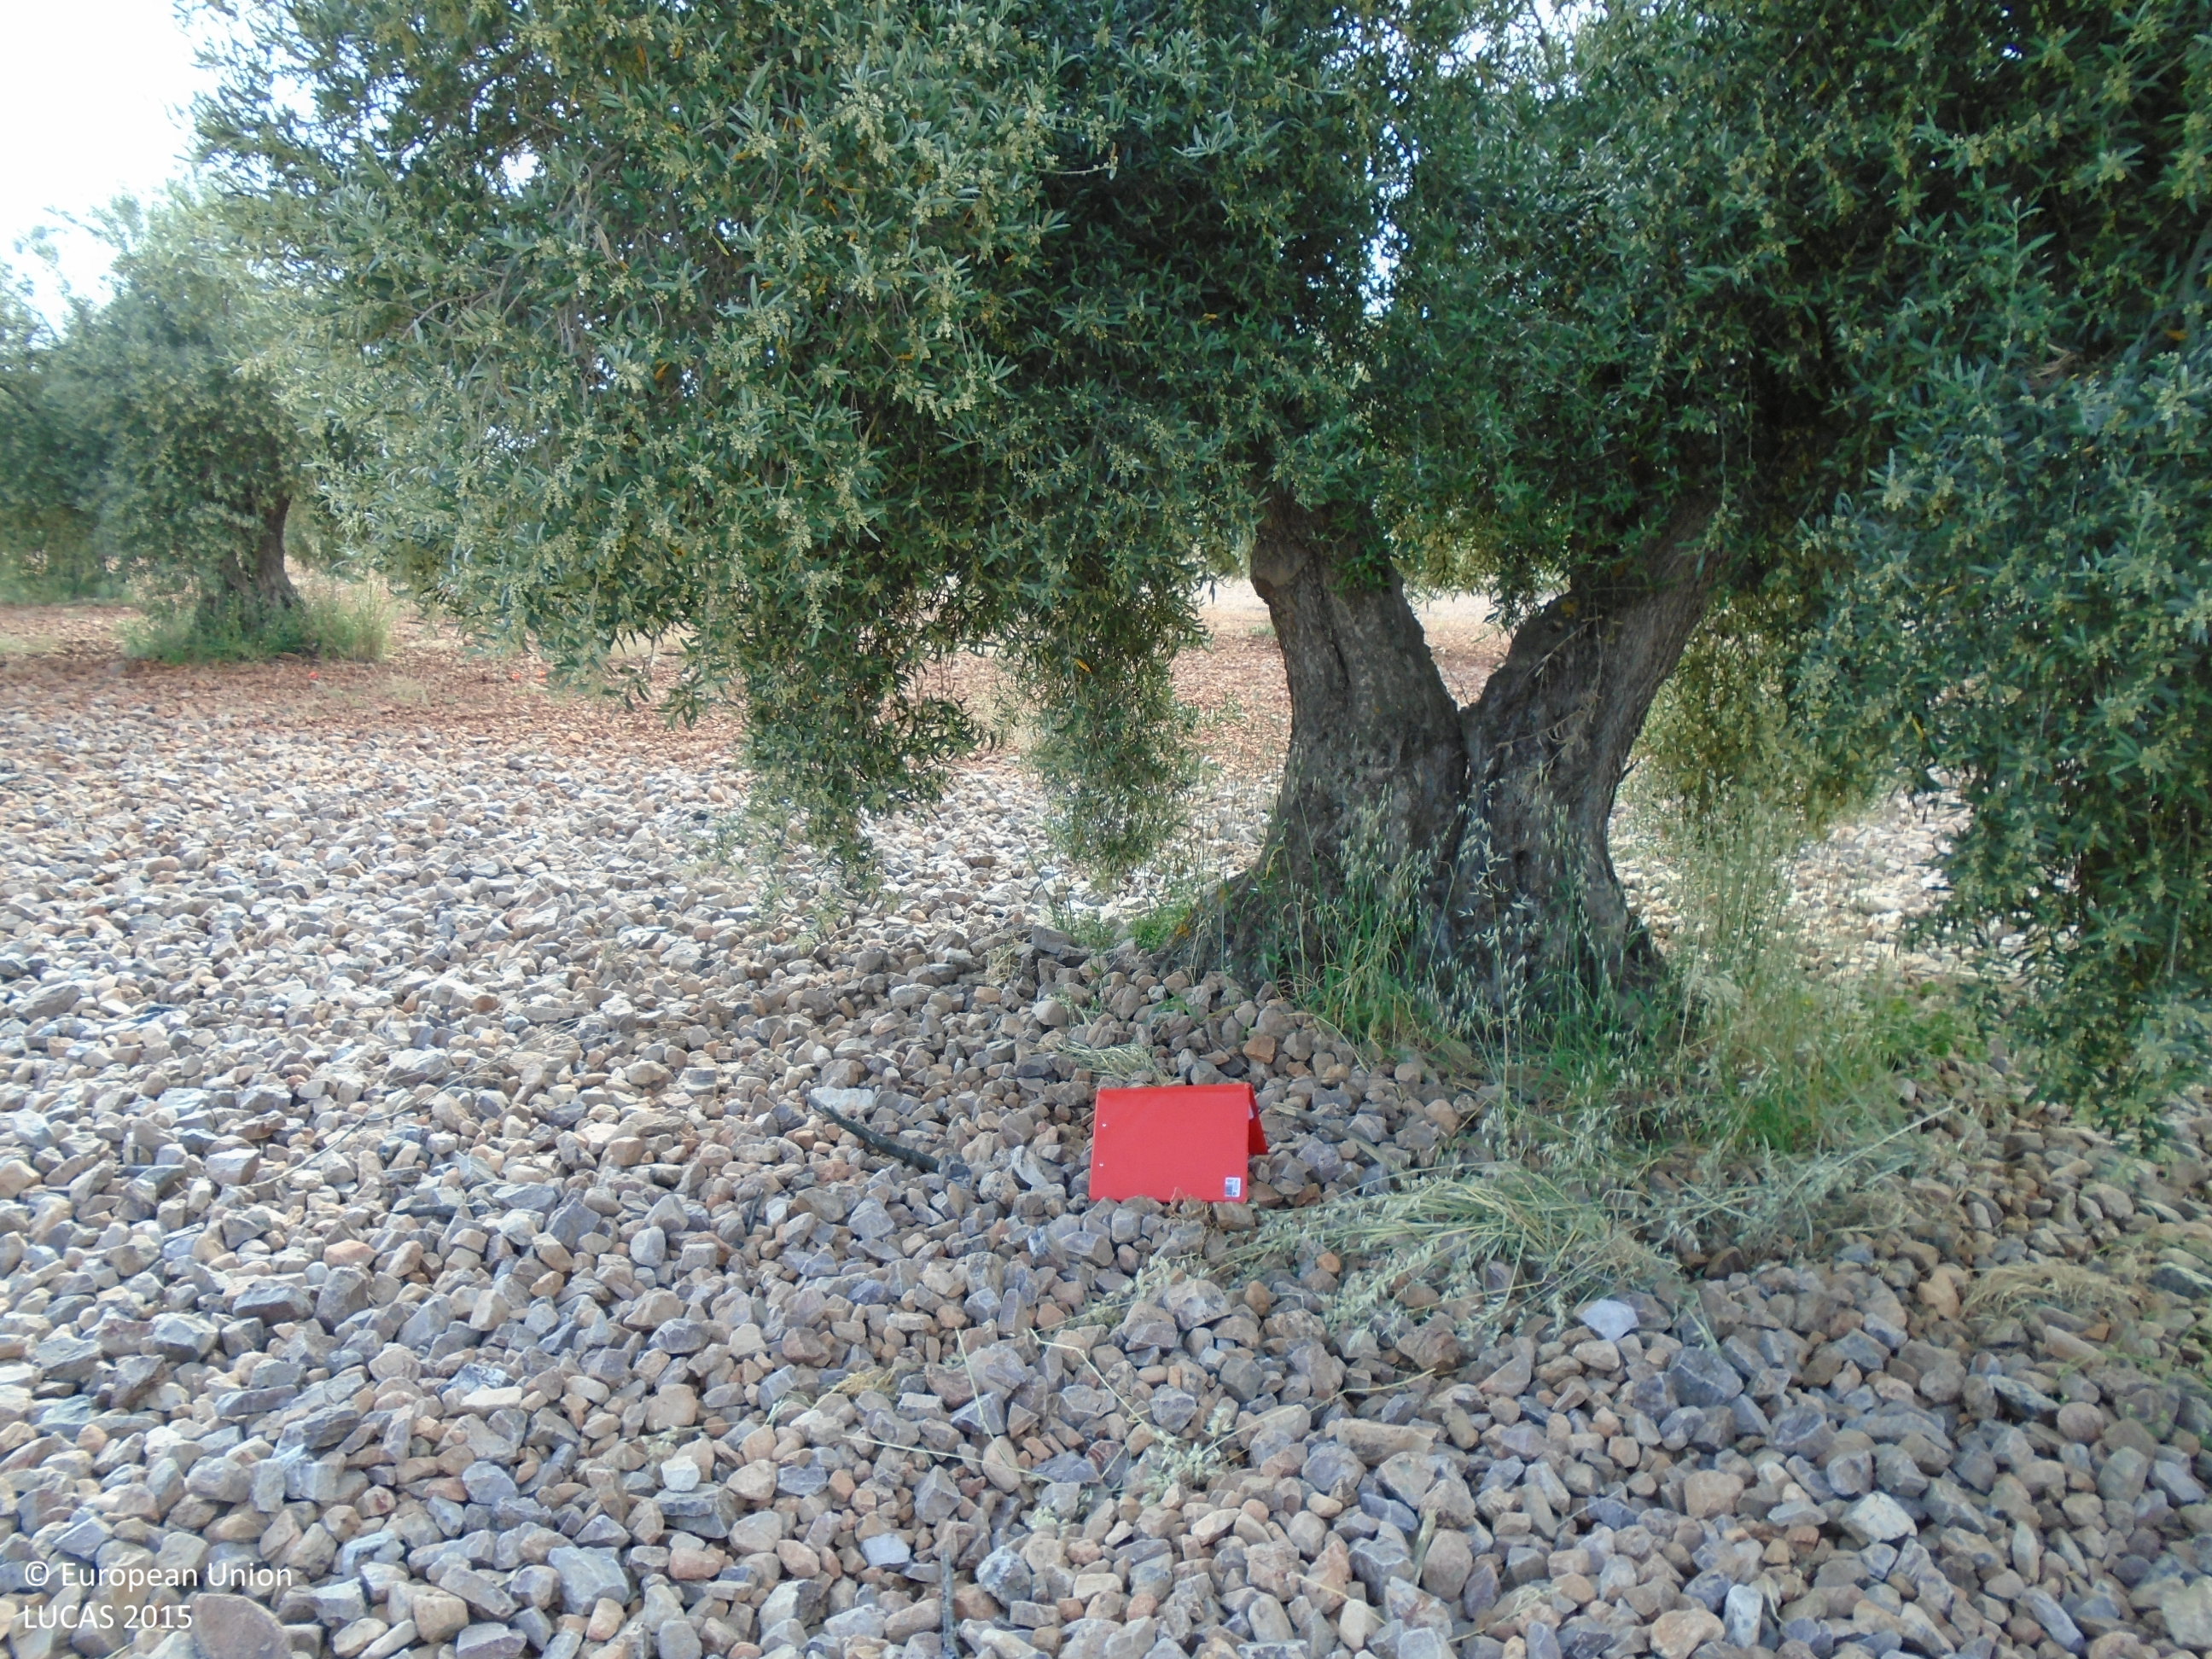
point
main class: Cropland
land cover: Olive groves
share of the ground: 10 - 25 %
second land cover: Other bare soil
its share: > 75 %
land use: Agriculture (excluding fallow land and kitchen gardens)
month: May
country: ES
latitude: 39.5900
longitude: -3.7317
